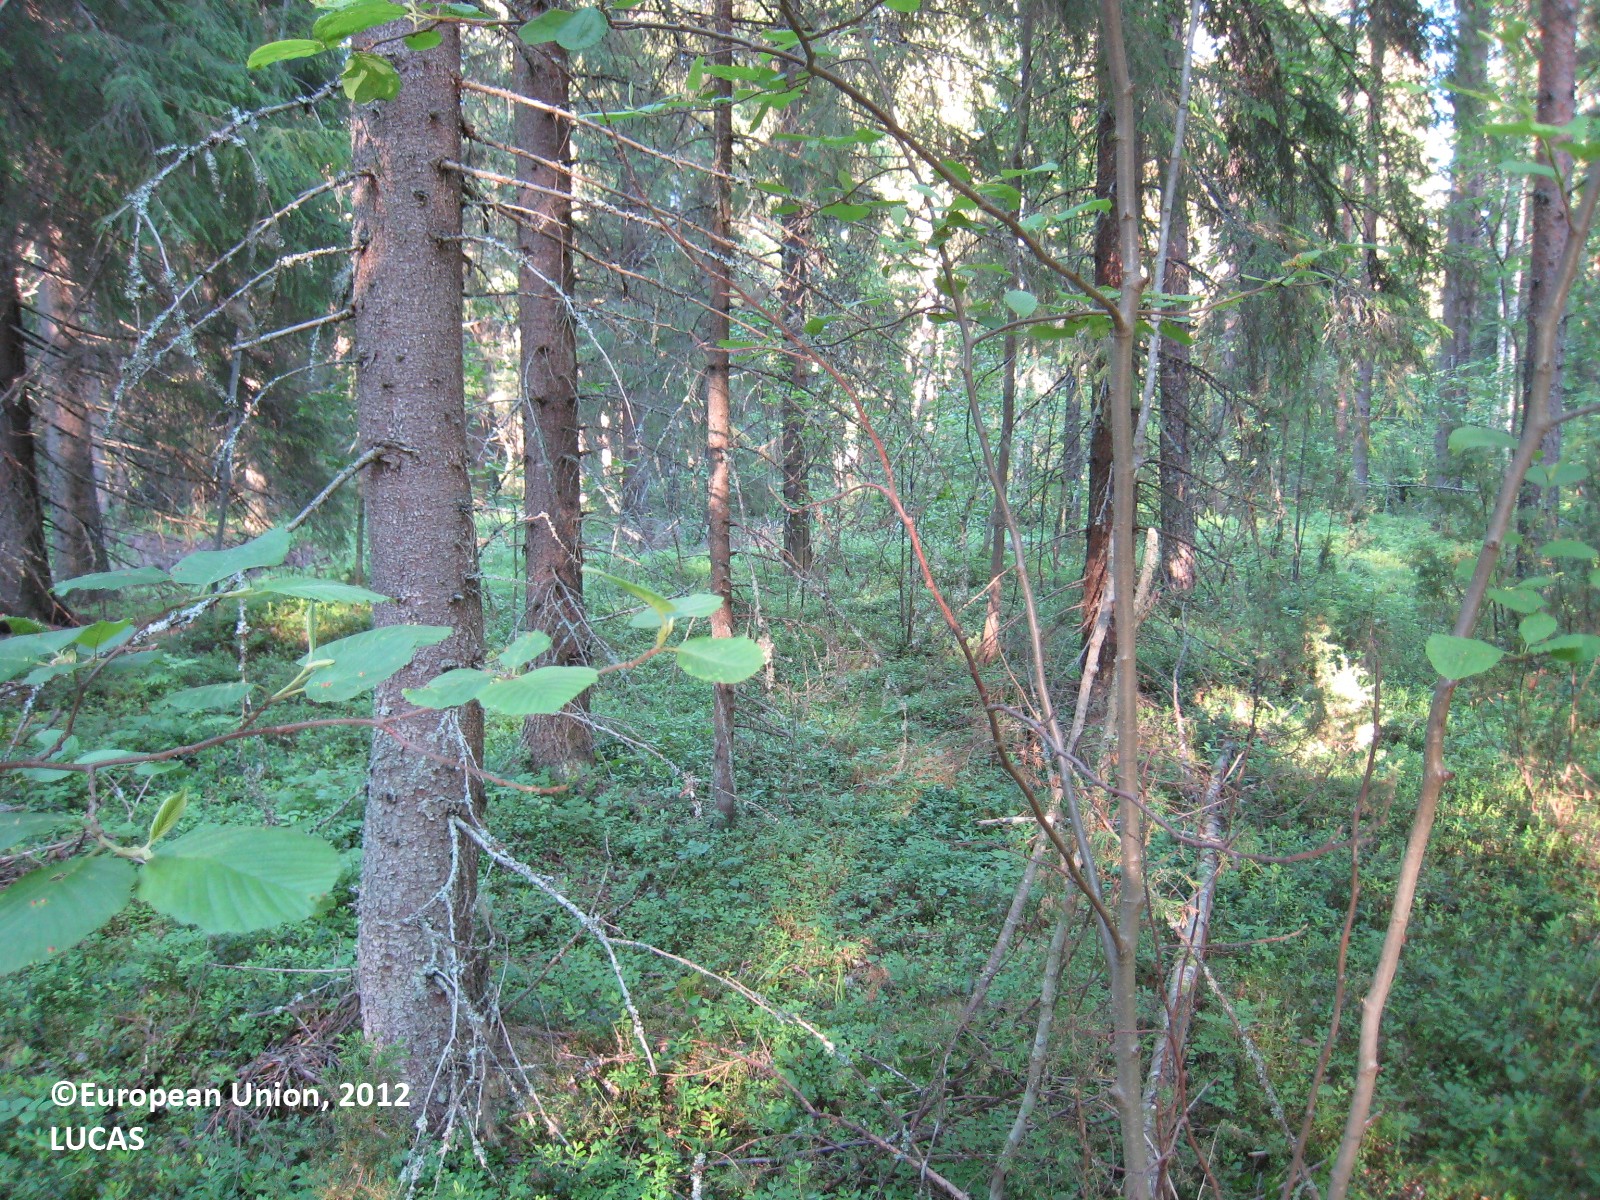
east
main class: Woodland
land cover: Other coniferous woodland
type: boreal forest
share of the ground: 50 - 75 %
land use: Forestry
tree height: > 5 m
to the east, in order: Other coniferous woodland; Spruce dominated coniferous woodland; Other mixed woodland; Ditches and canals; Spruce dominated coniferous woodland; Ditches and canals; Other coniferous woodland; Ditches and canals; Other mixed woodland; Ditches and canals; Other mixed woodland; Ditches and canals; Other coniferous woodland; Ditches and canals; Spruce dominated mixed woodland; Ditches and canals; Spruce dominated mixed woodland; Ditches and canals; Spruce dominated mixed woodland
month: June
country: FI
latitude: 62.3793
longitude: 26.4758
